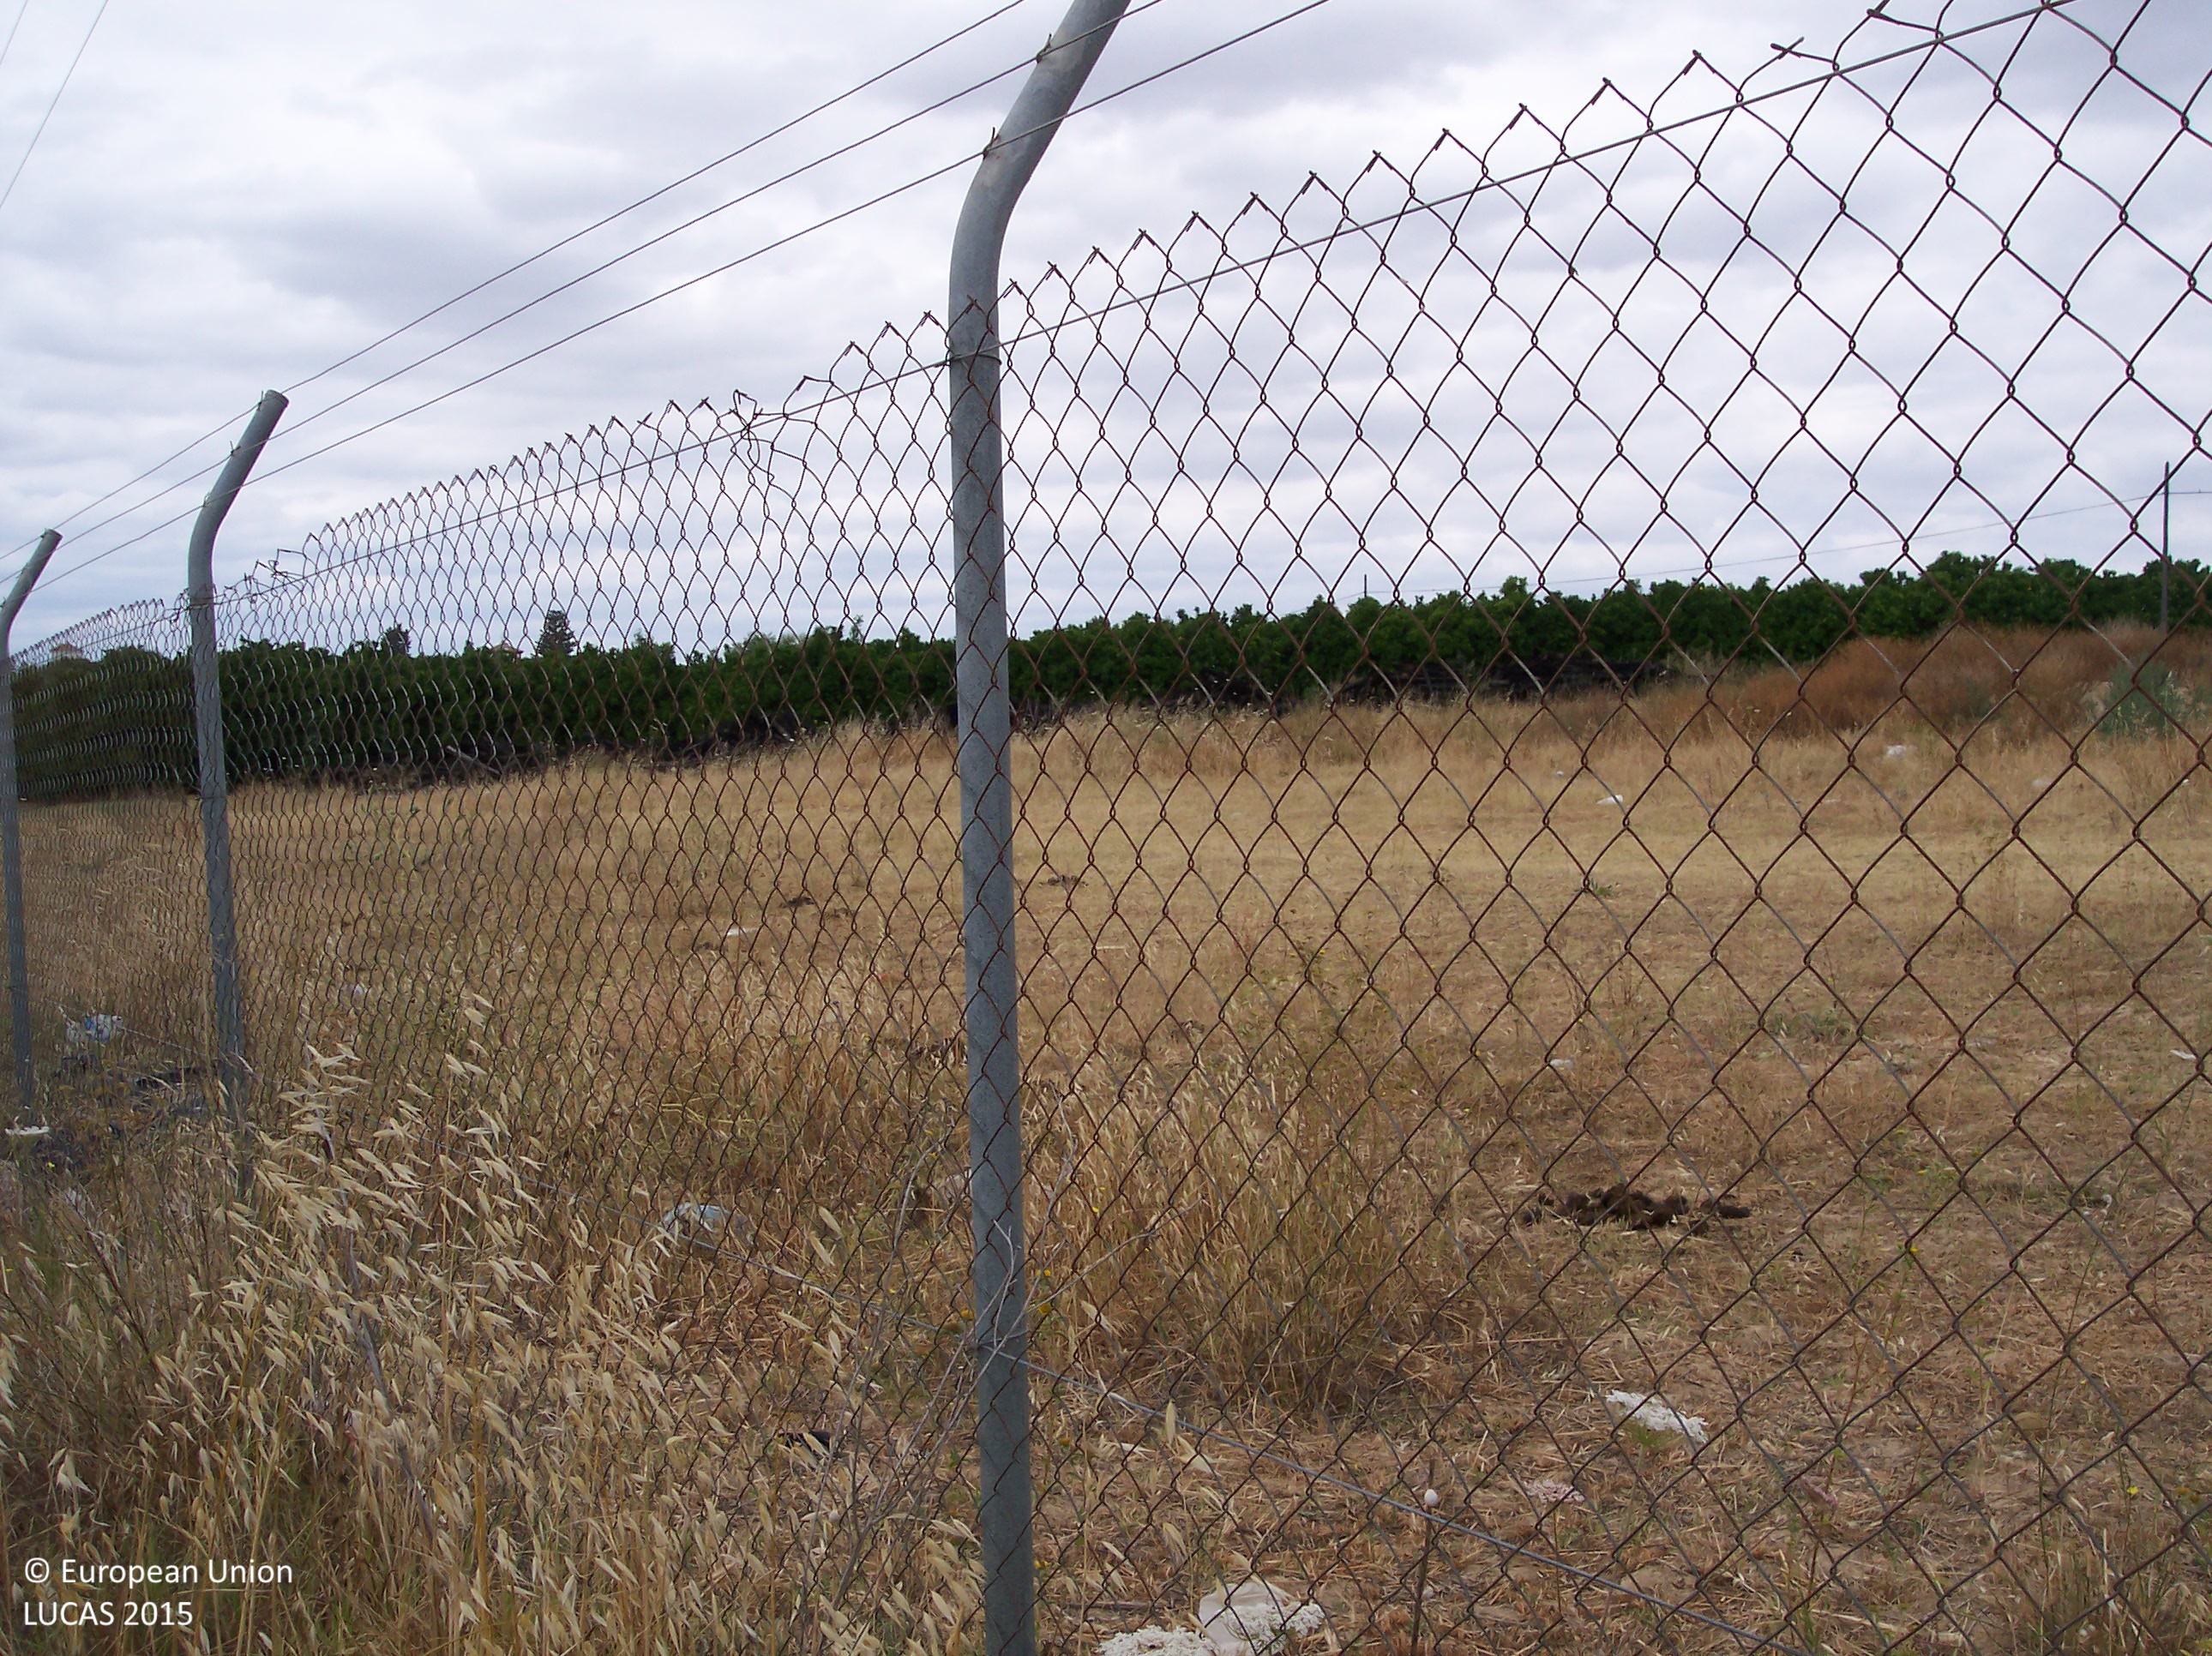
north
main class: Grassland
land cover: Grassland without tree/shrub cover
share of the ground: > 75 %
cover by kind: herbaceous plants 75 %, unconsolidated bare surface 20 %, shrubs 5 %
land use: Agriculture (excluding fallow land and kitchen gardens)
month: June
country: ES
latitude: 37.3135
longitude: -6.3786
